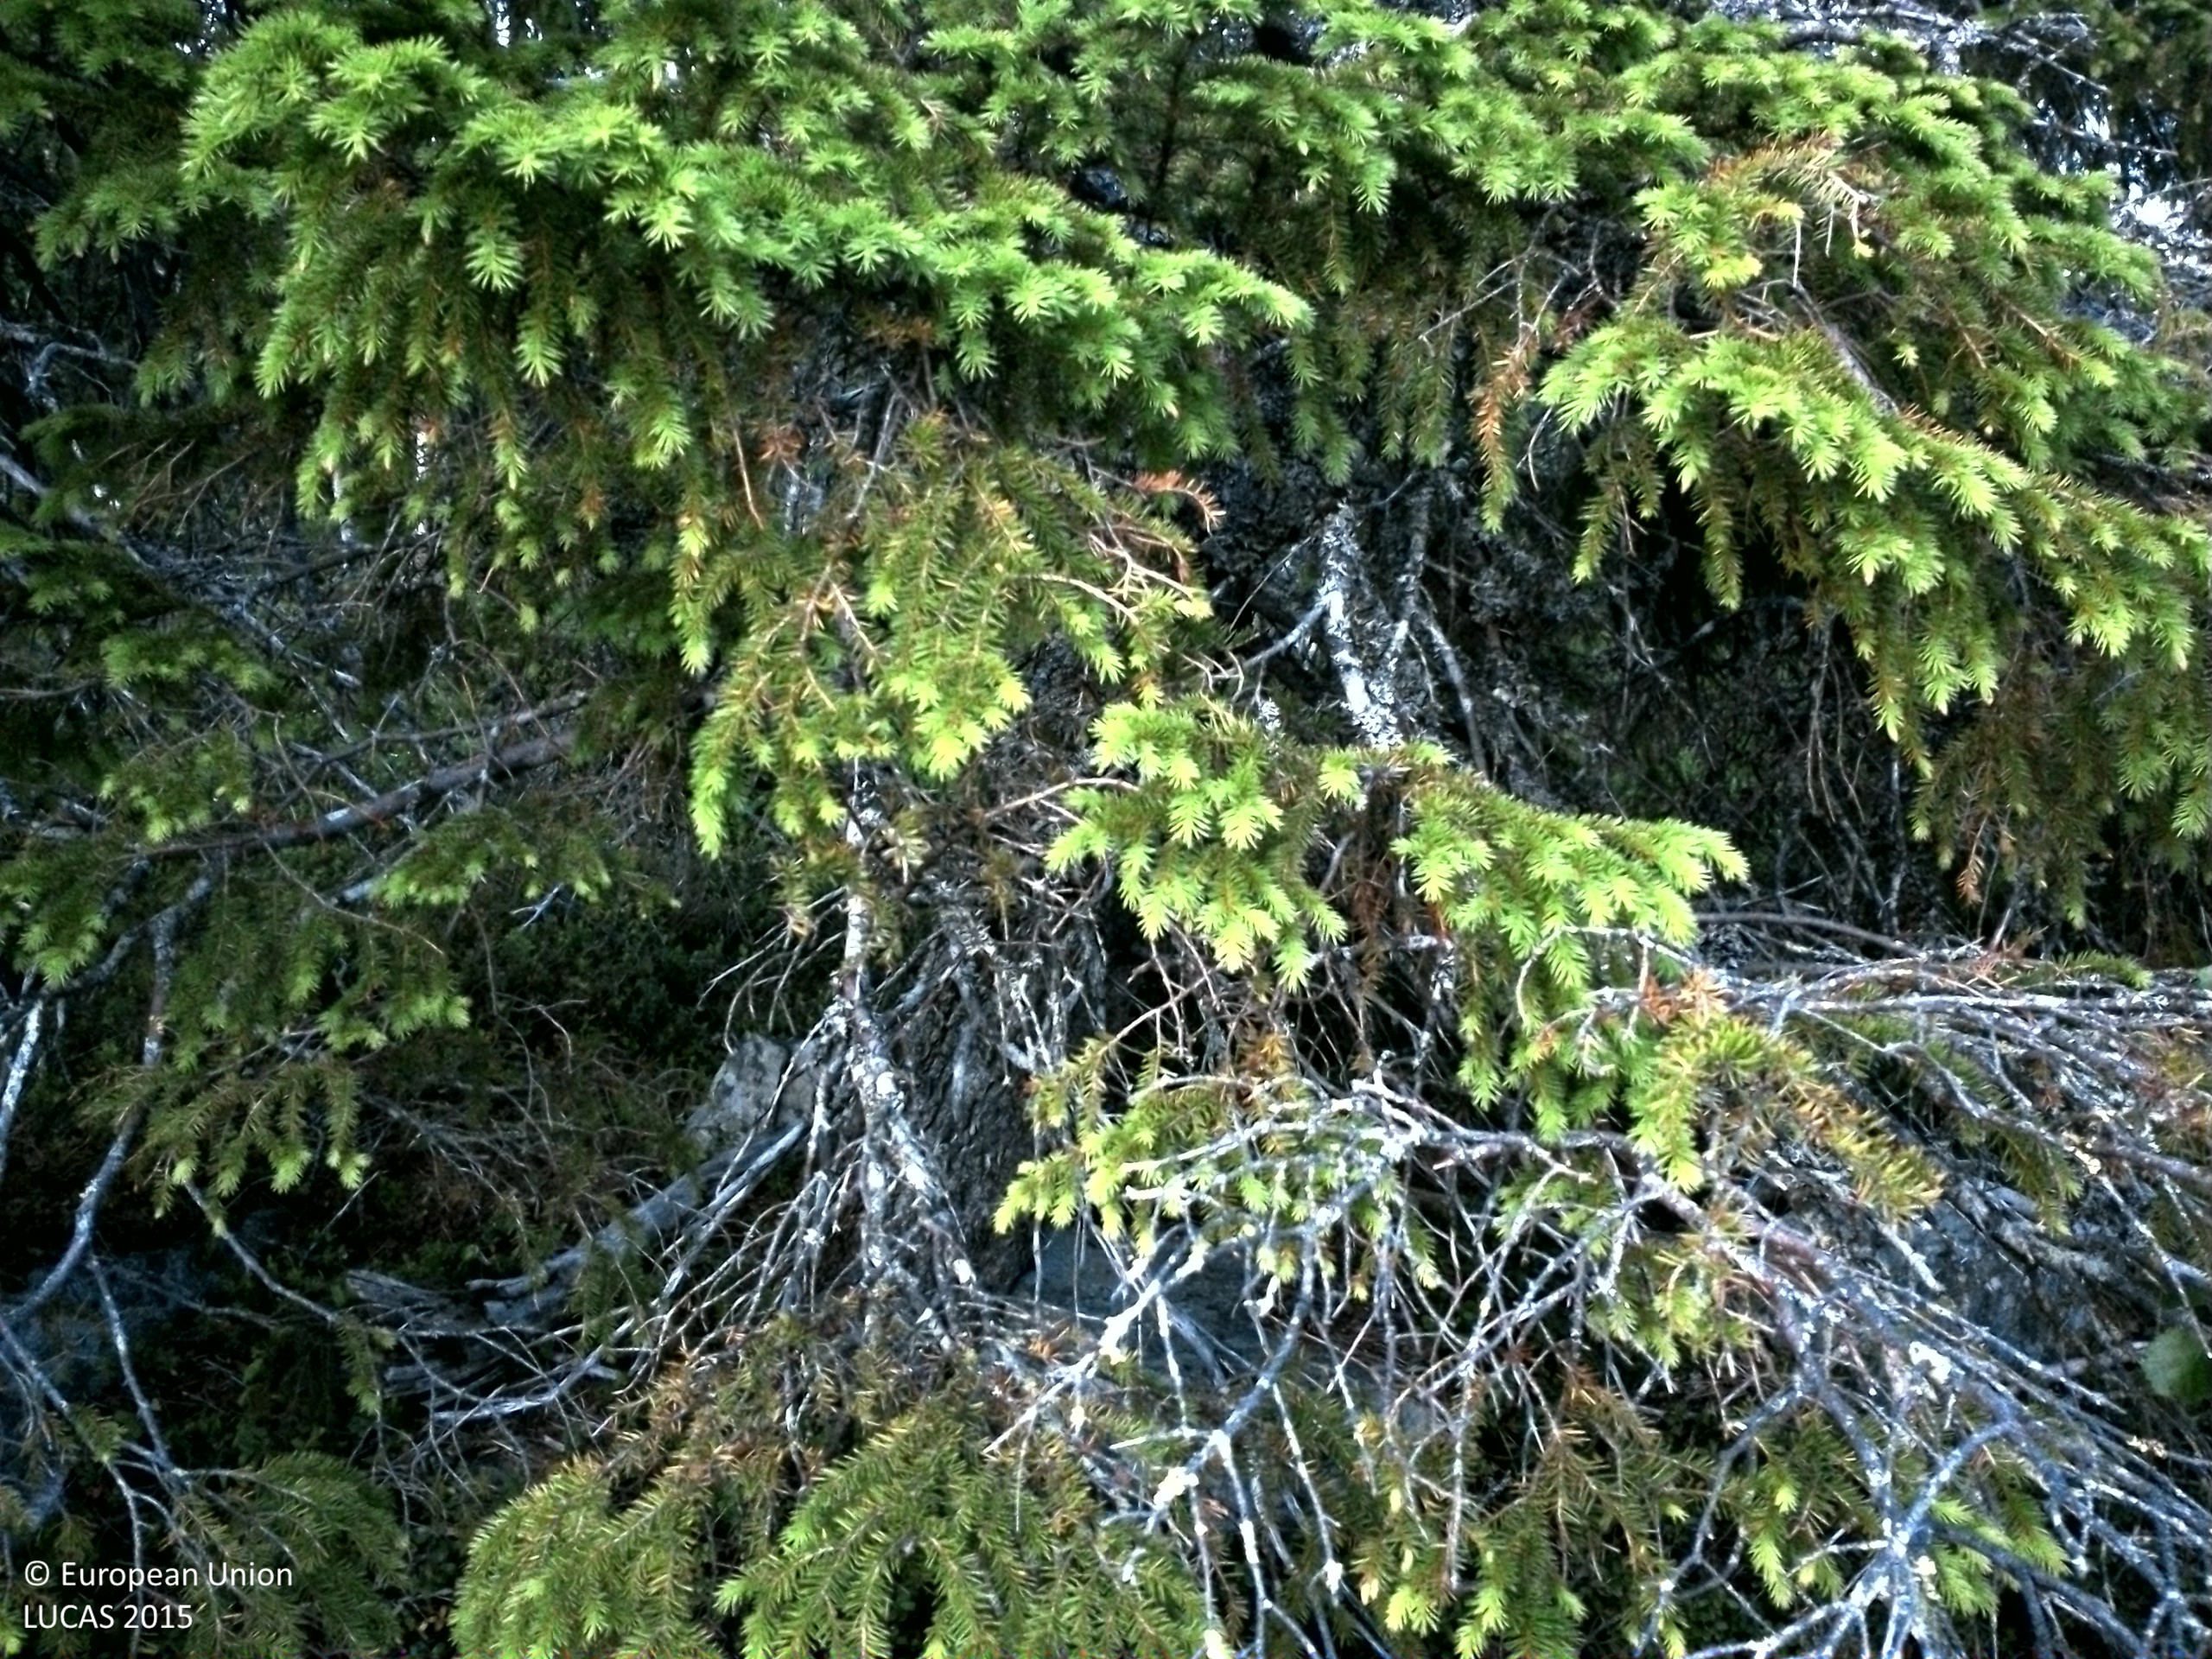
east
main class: Woodland
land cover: Spruce dominated mixed woodland
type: boreal forest
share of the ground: 50 - 75 %
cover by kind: coniferous forest trees 35 %, shrubs 35 %, broadleaved forest trees 15 %, herbaceous plants 10 %, consolidated bare surface 5 %
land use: Forestry
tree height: > 5 m
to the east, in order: Spruce dominated mixed woodland; Shrubland with sparse tree cover; Peatbogs; Spruce dominated mixed woodland
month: July
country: SE
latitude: 64.7792
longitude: 15.3327
